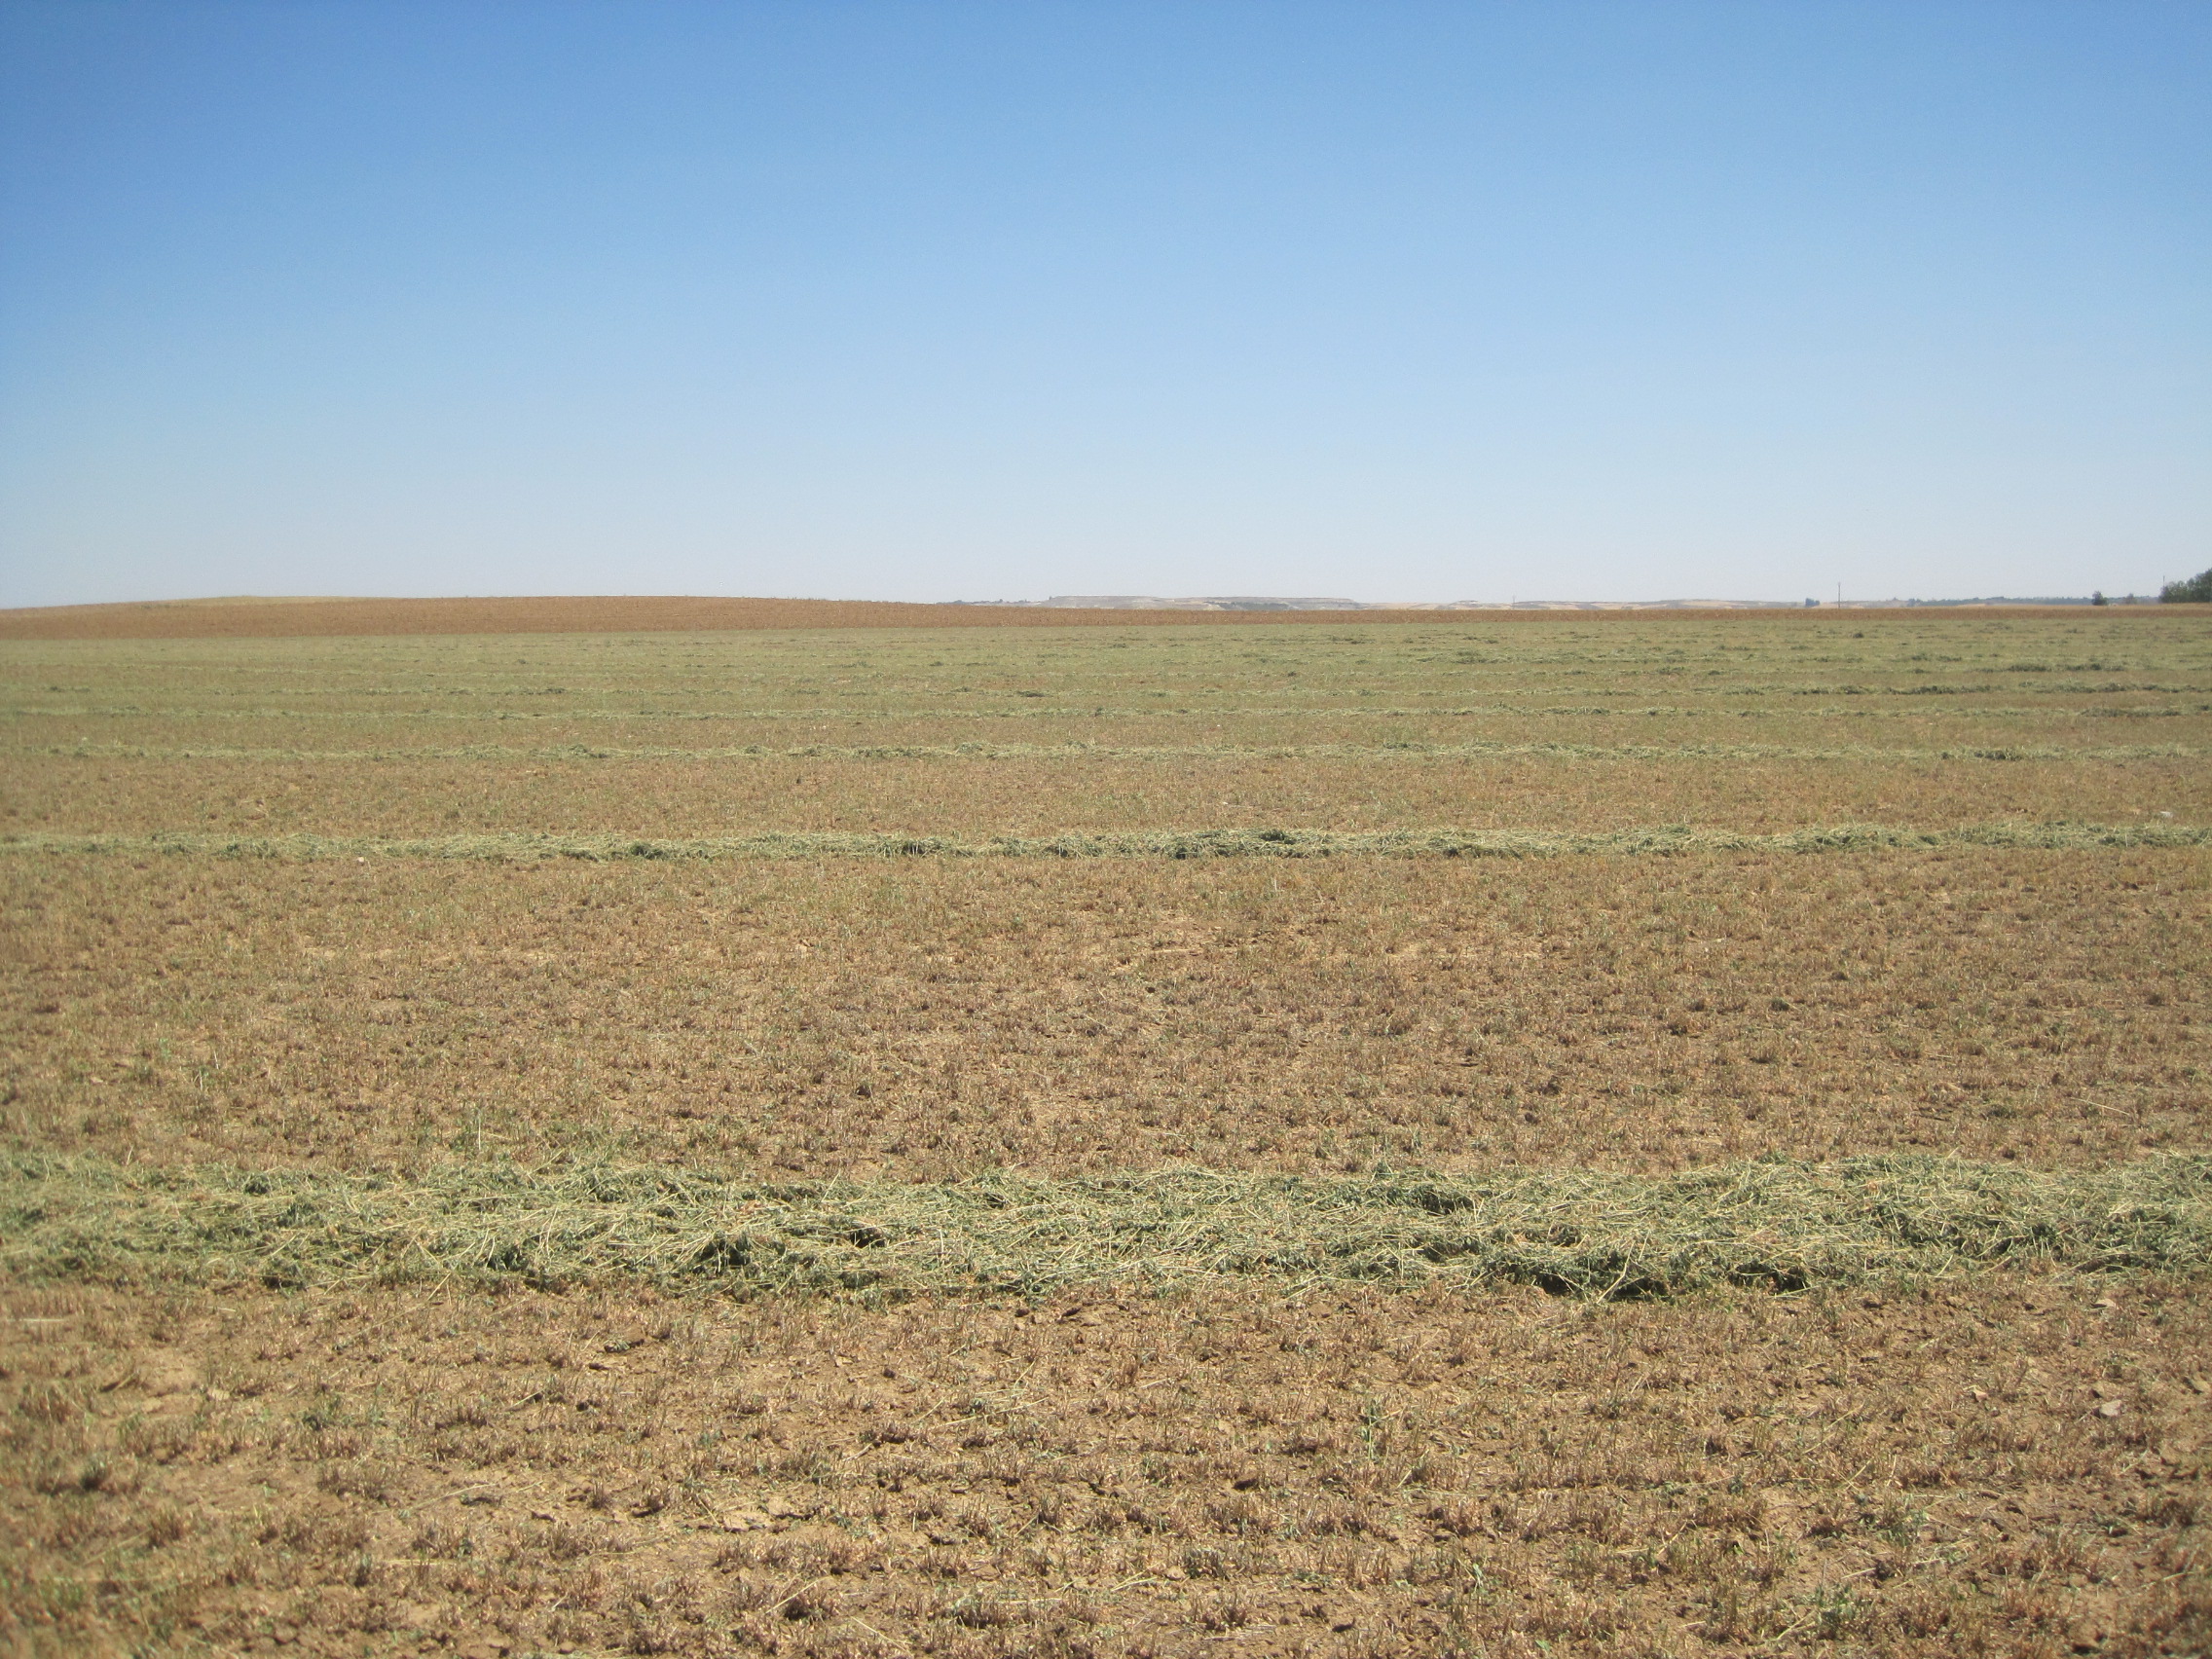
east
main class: Cropland
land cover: Lucerne
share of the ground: < 10 %
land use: Agriculture (excluding fallow land and kitchen gardens)
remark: Harvested field
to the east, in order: Lucerne; Other bare soil; Lucerne
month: July
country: ES
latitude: 41.9904
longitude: -4.7398
